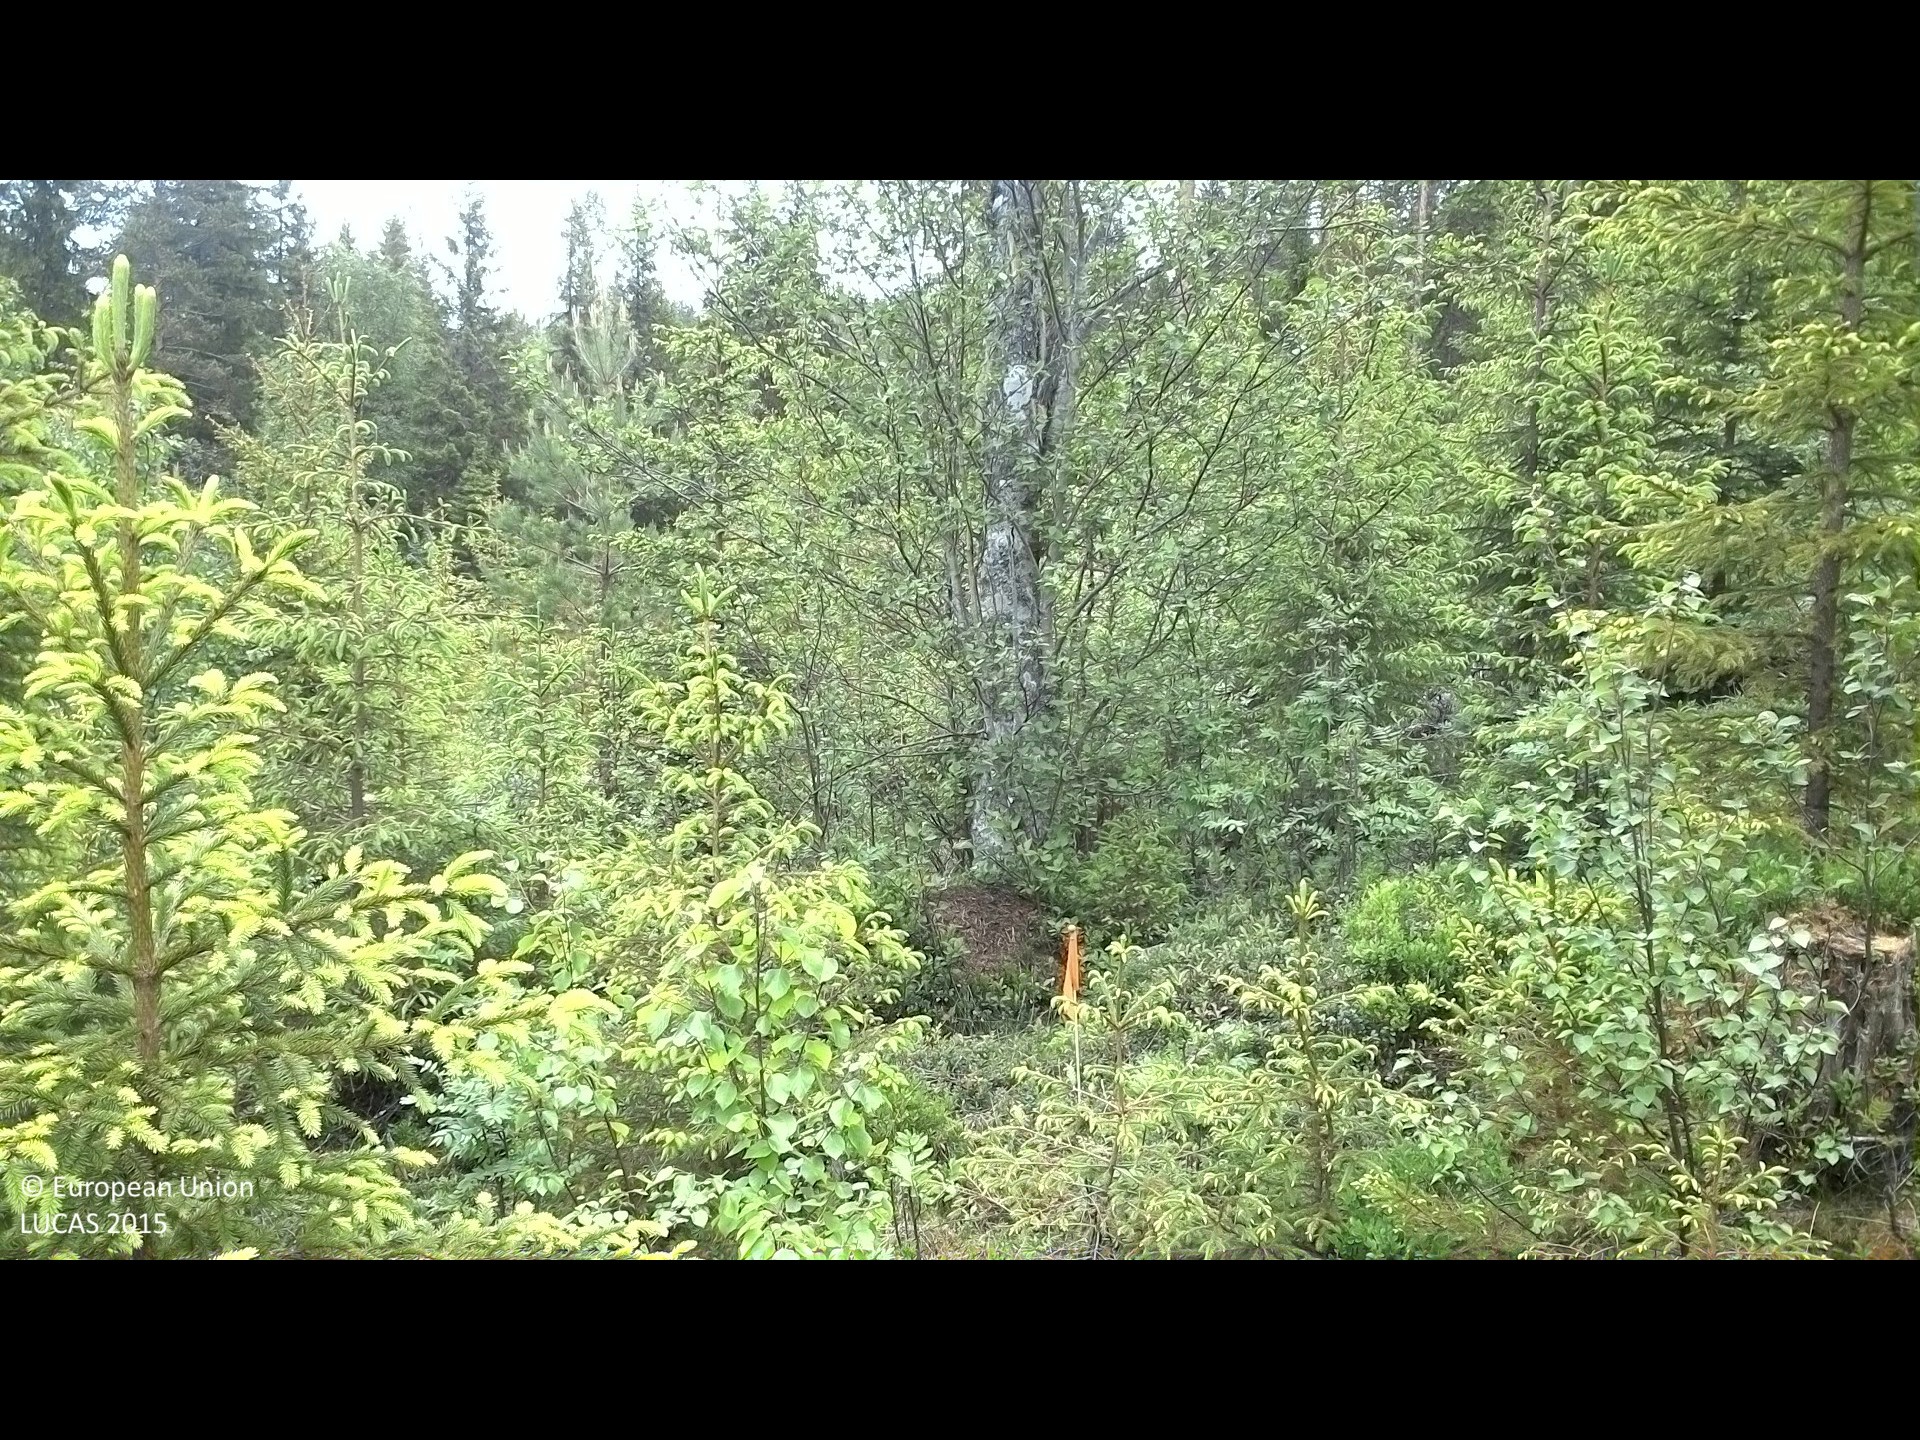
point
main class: Woodland
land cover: Spruce dominated mixed woodland
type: boreal forest
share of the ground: 25 - 50 %
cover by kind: coniferous forest trees 30 %, shrubs 30 %, lichens and mosses 25 %, broadleaved forest trees 15 %
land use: Forestry
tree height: < 5 m
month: June
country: SE
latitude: 61.9917
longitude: 16.7202
